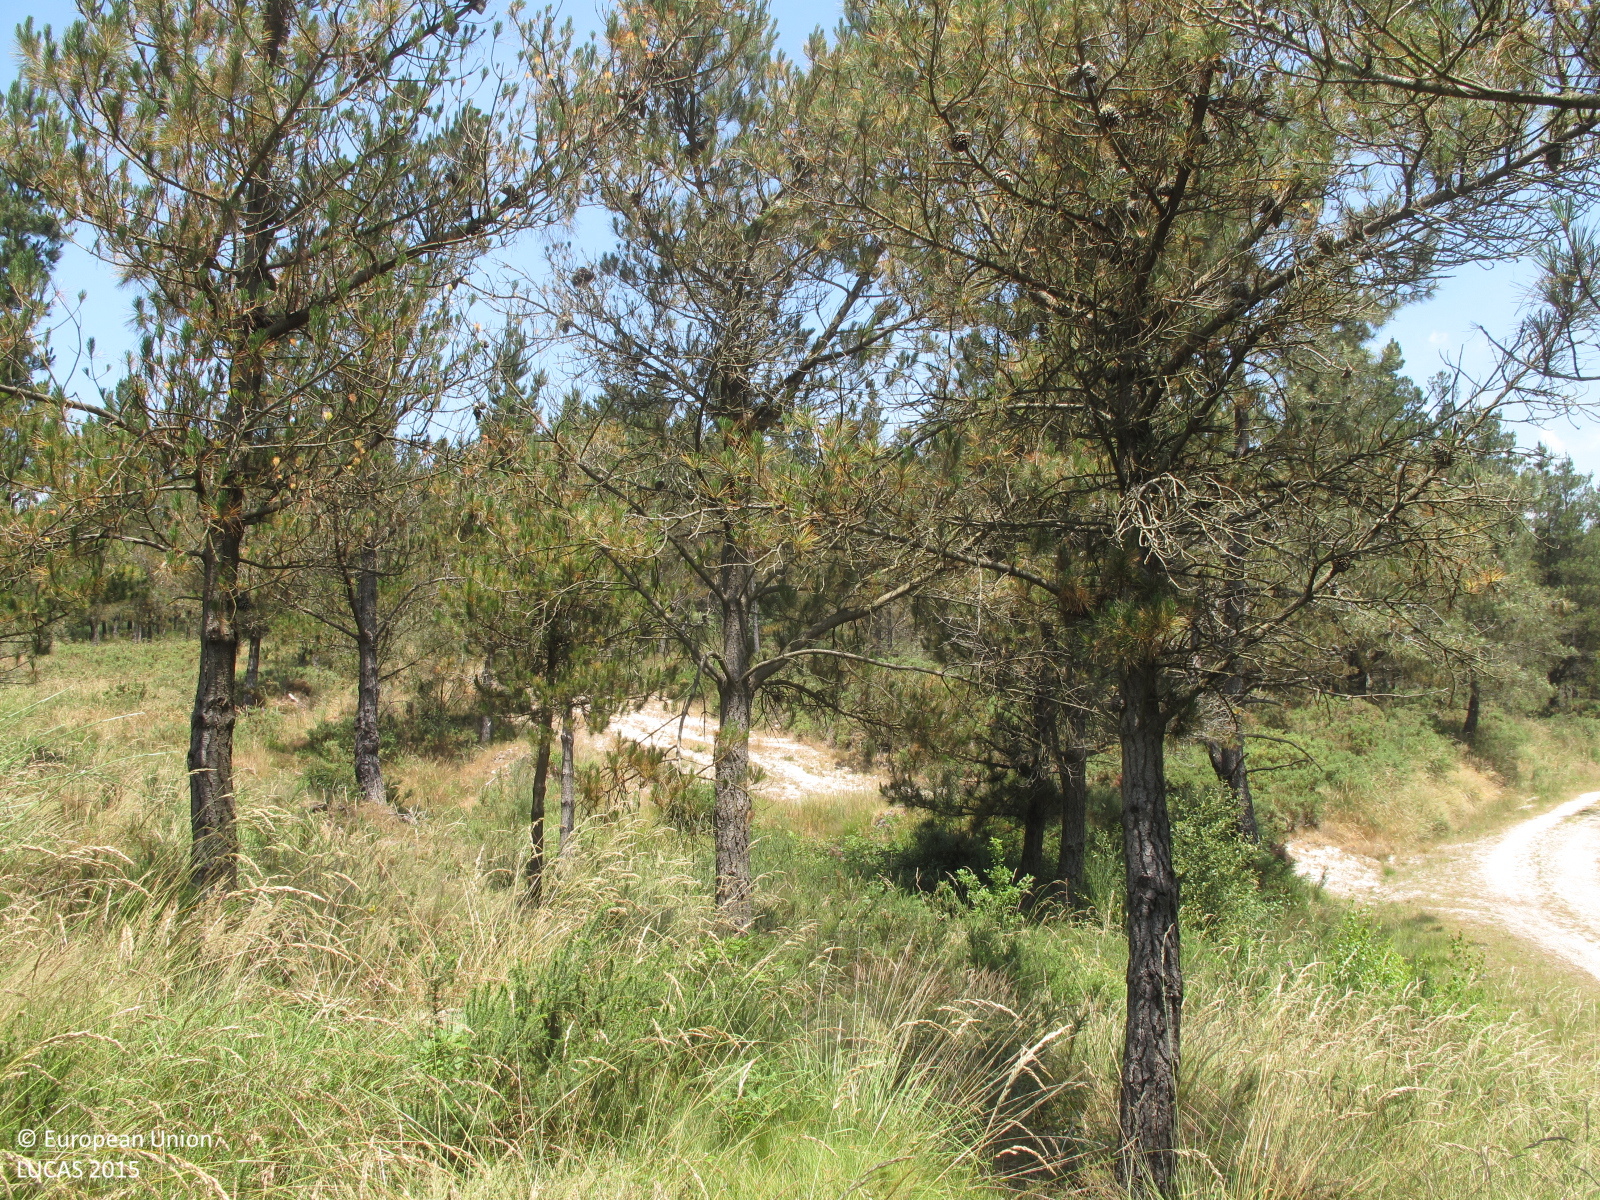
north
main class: Woodland
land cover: Pine dominated coniferous woodland
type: exotic forest
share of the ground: 25 - 50 %
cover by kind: herbaceous plants 40 %, coniferous forest trees 30 %, shrubs 30 %
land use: Forestry
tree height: > 5 m
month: June
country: ES
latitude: 43.2554
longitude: -7.9145
